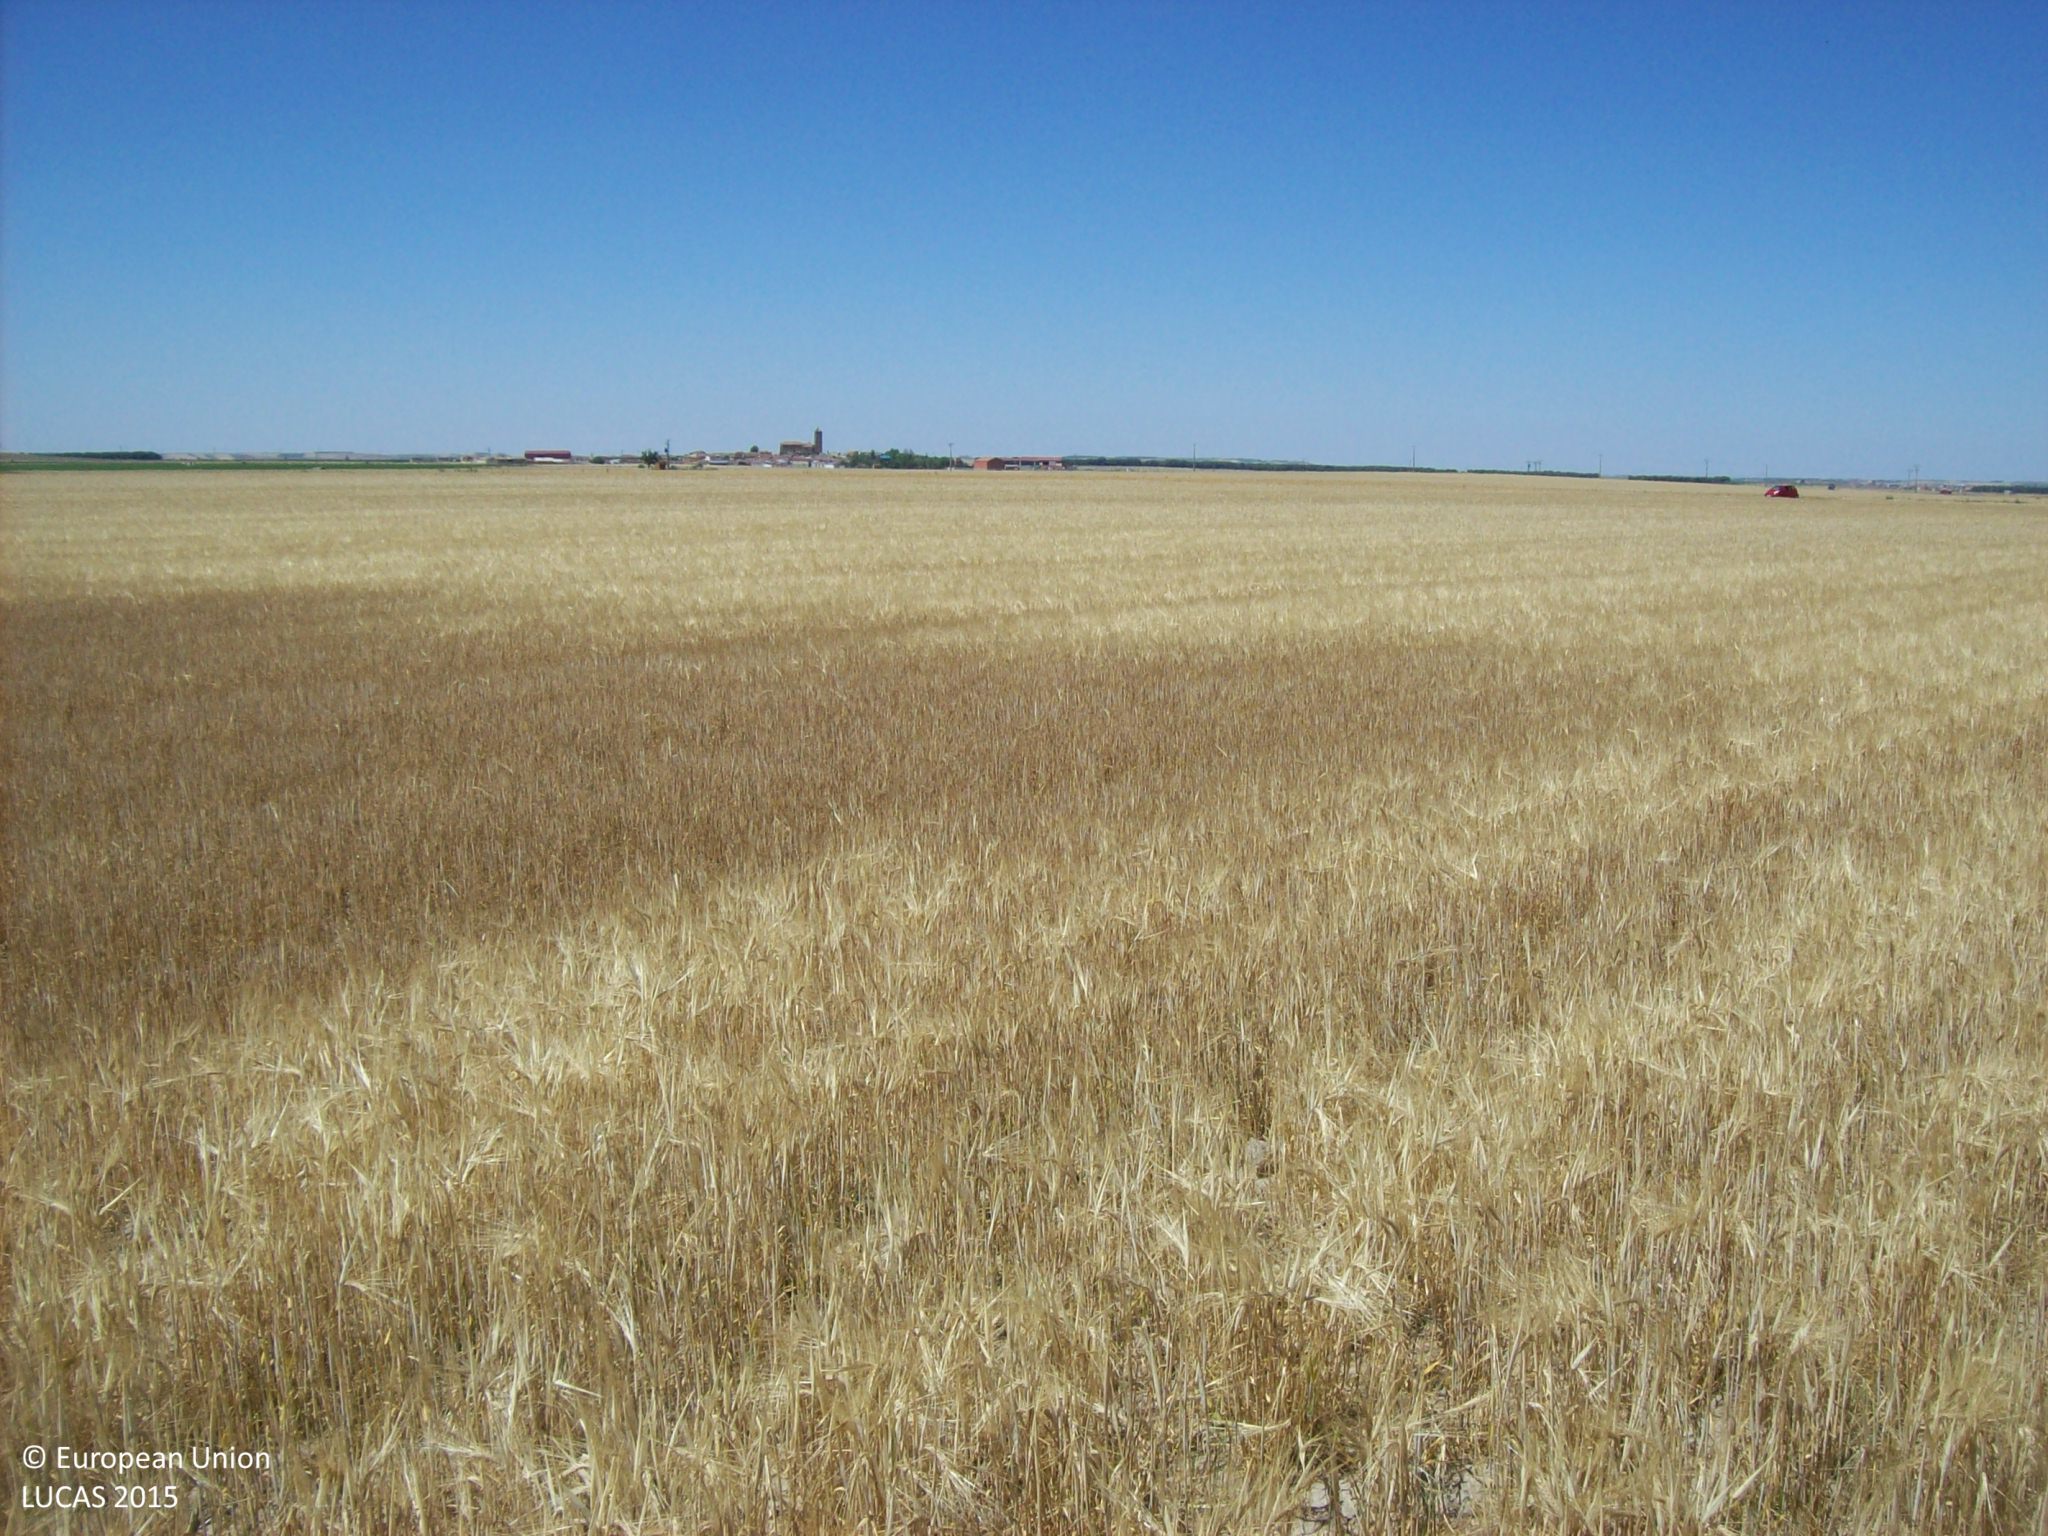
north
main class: Cropland
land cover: Barley
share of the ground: > 75 %
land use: Agriculture (excluding fallow land and kitchen gardens)
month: June
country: ES
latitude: 41.2122
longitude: -5.0371
